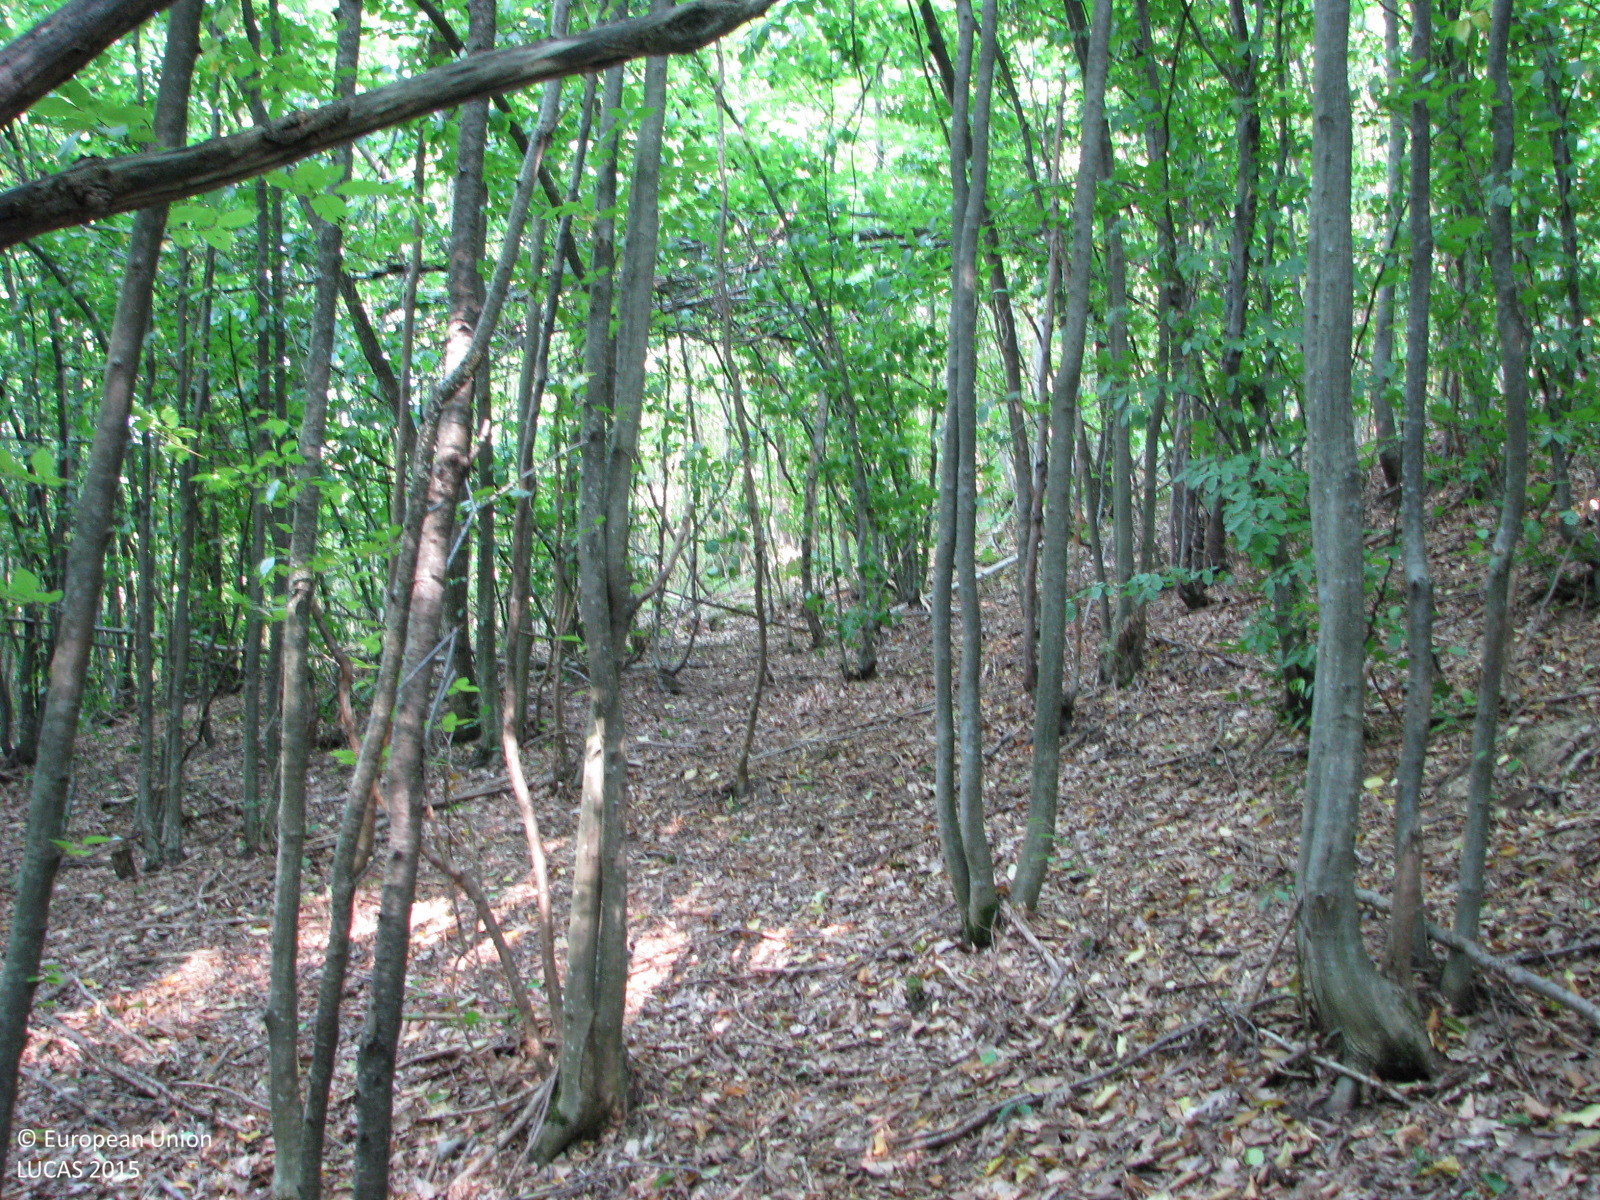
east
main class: Woodland
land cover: Broadleaved woodland
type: beech forest
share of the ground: 50 - 75 %
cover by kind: broadleaved forest trees 60 %, consolidated bare surface 25 %, shrubs 10 %, herbaceous plants 5 %
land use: Forestry
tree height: > 5 m
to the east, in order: Broadleaved woodland; Rivers and streams; Broadleaved woodland; Rivers and streams; Broadleaved woodland
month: August
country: BG
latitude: 42.8791
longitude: 26.1138
